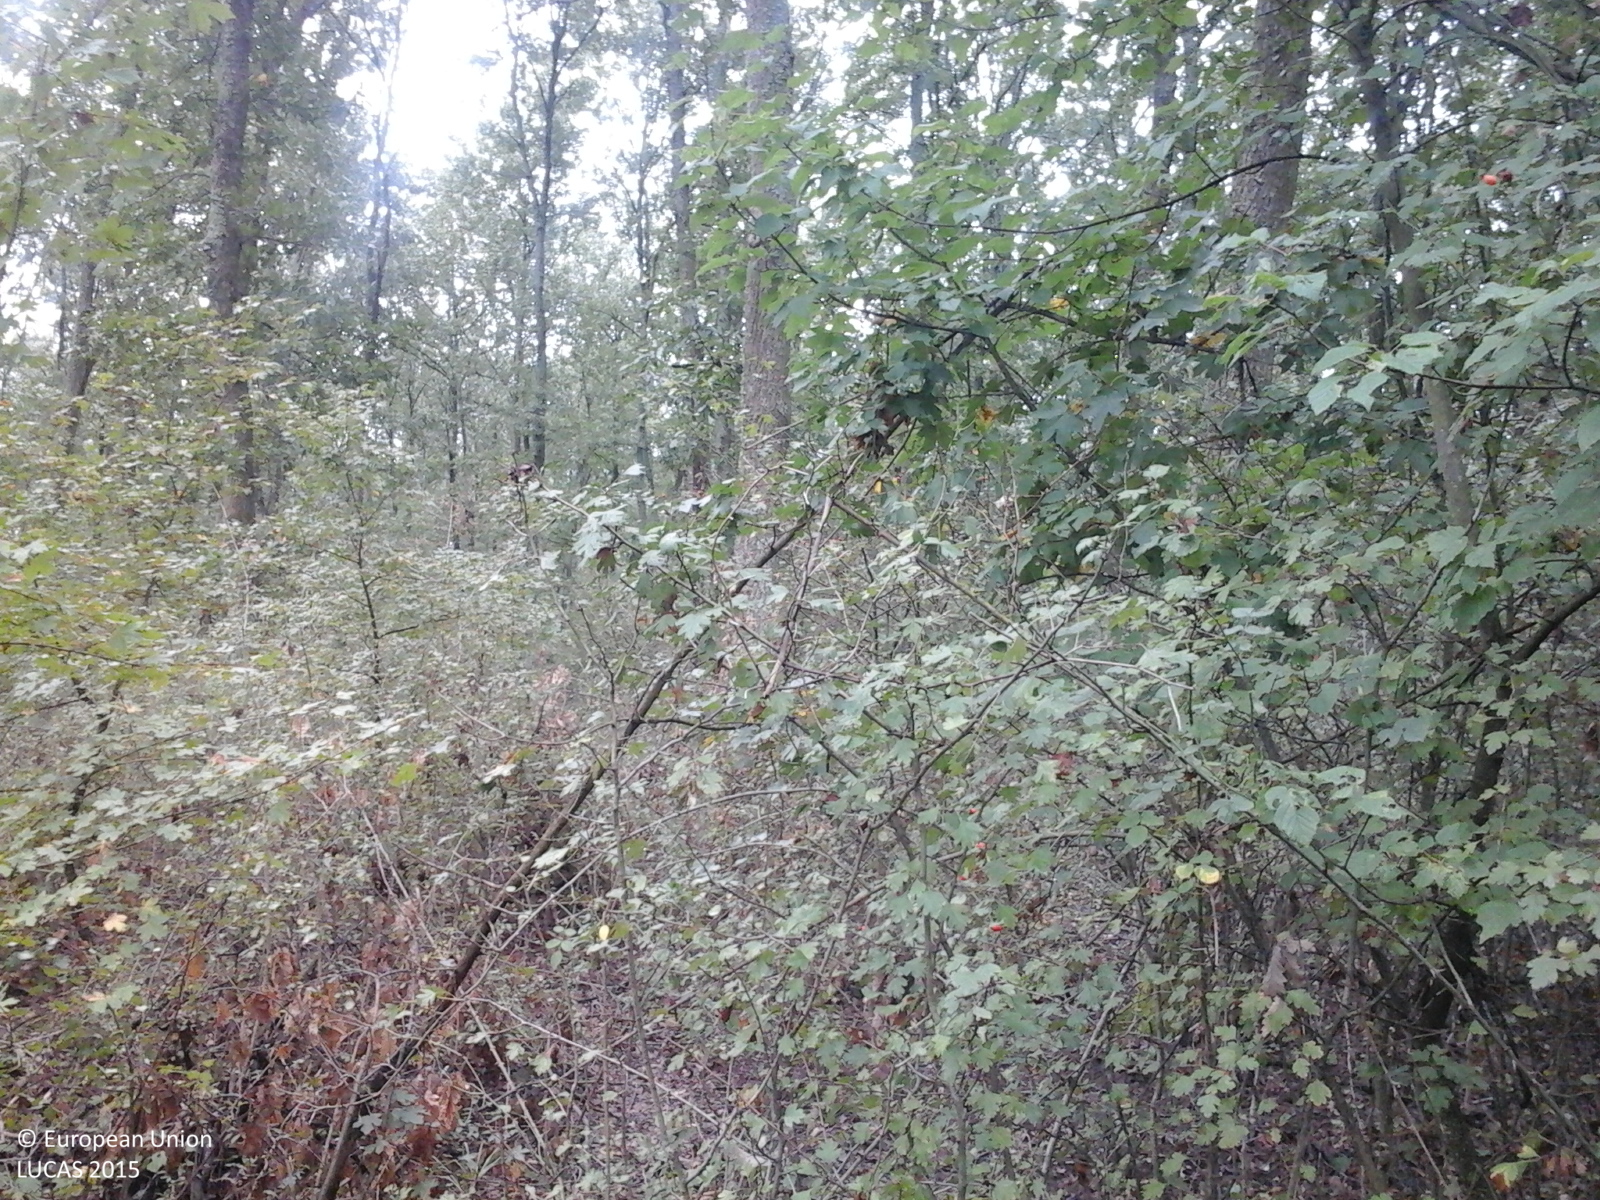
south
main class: Woodland
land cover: Broadleaved woodland
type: acidophilous oak and oak-birch forest
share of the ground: > 75 %
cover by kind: broadleaved forest trees 80 %, shrubs 10 %, herbaceous plants 10 %
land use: Forestry
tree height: > 5 m
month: September
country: RO
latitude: 46.8027
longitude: 21.8232
